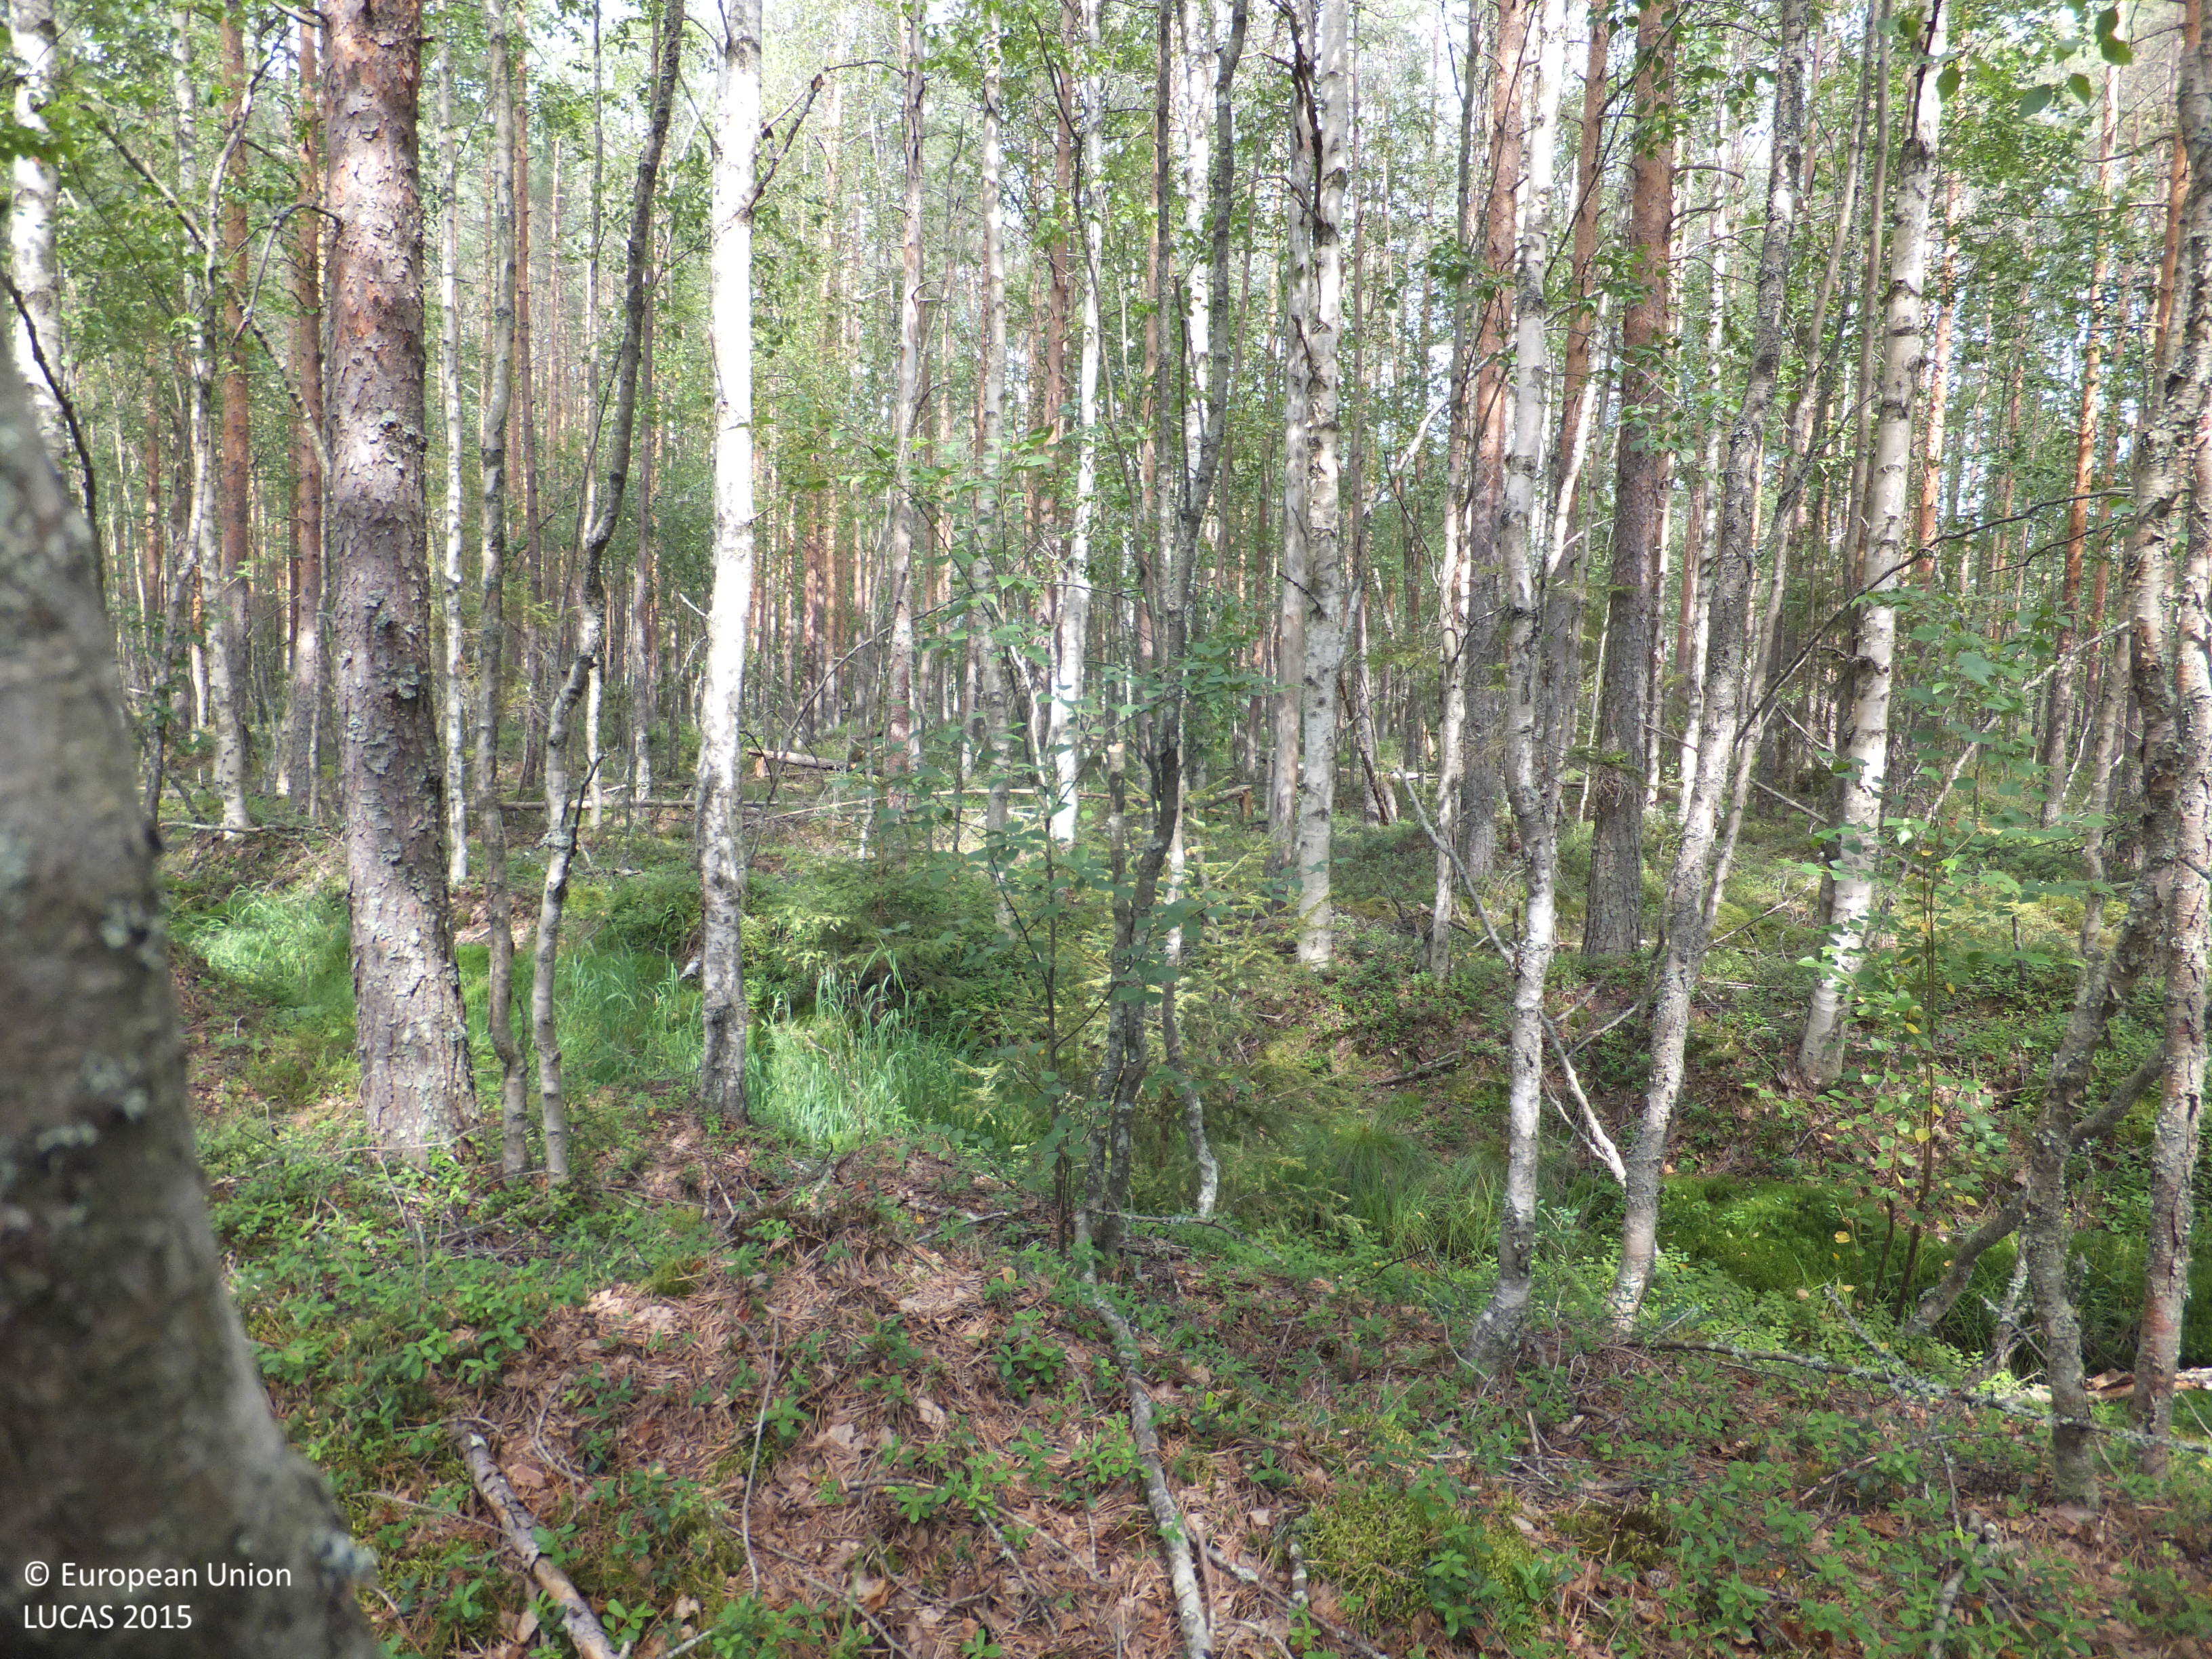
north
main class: Woodland
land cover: Pine dominated mixed woodland
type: boreal forest
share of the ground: > 75 %
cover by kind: coniferous forest trees 40 %, broadleaved forest trees 40 %, shrubs 15 %, lichens and mosses 5 %
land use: Forestry
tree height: > 5 m
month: August
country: FI
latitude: 63.1672
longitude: 22.7423
